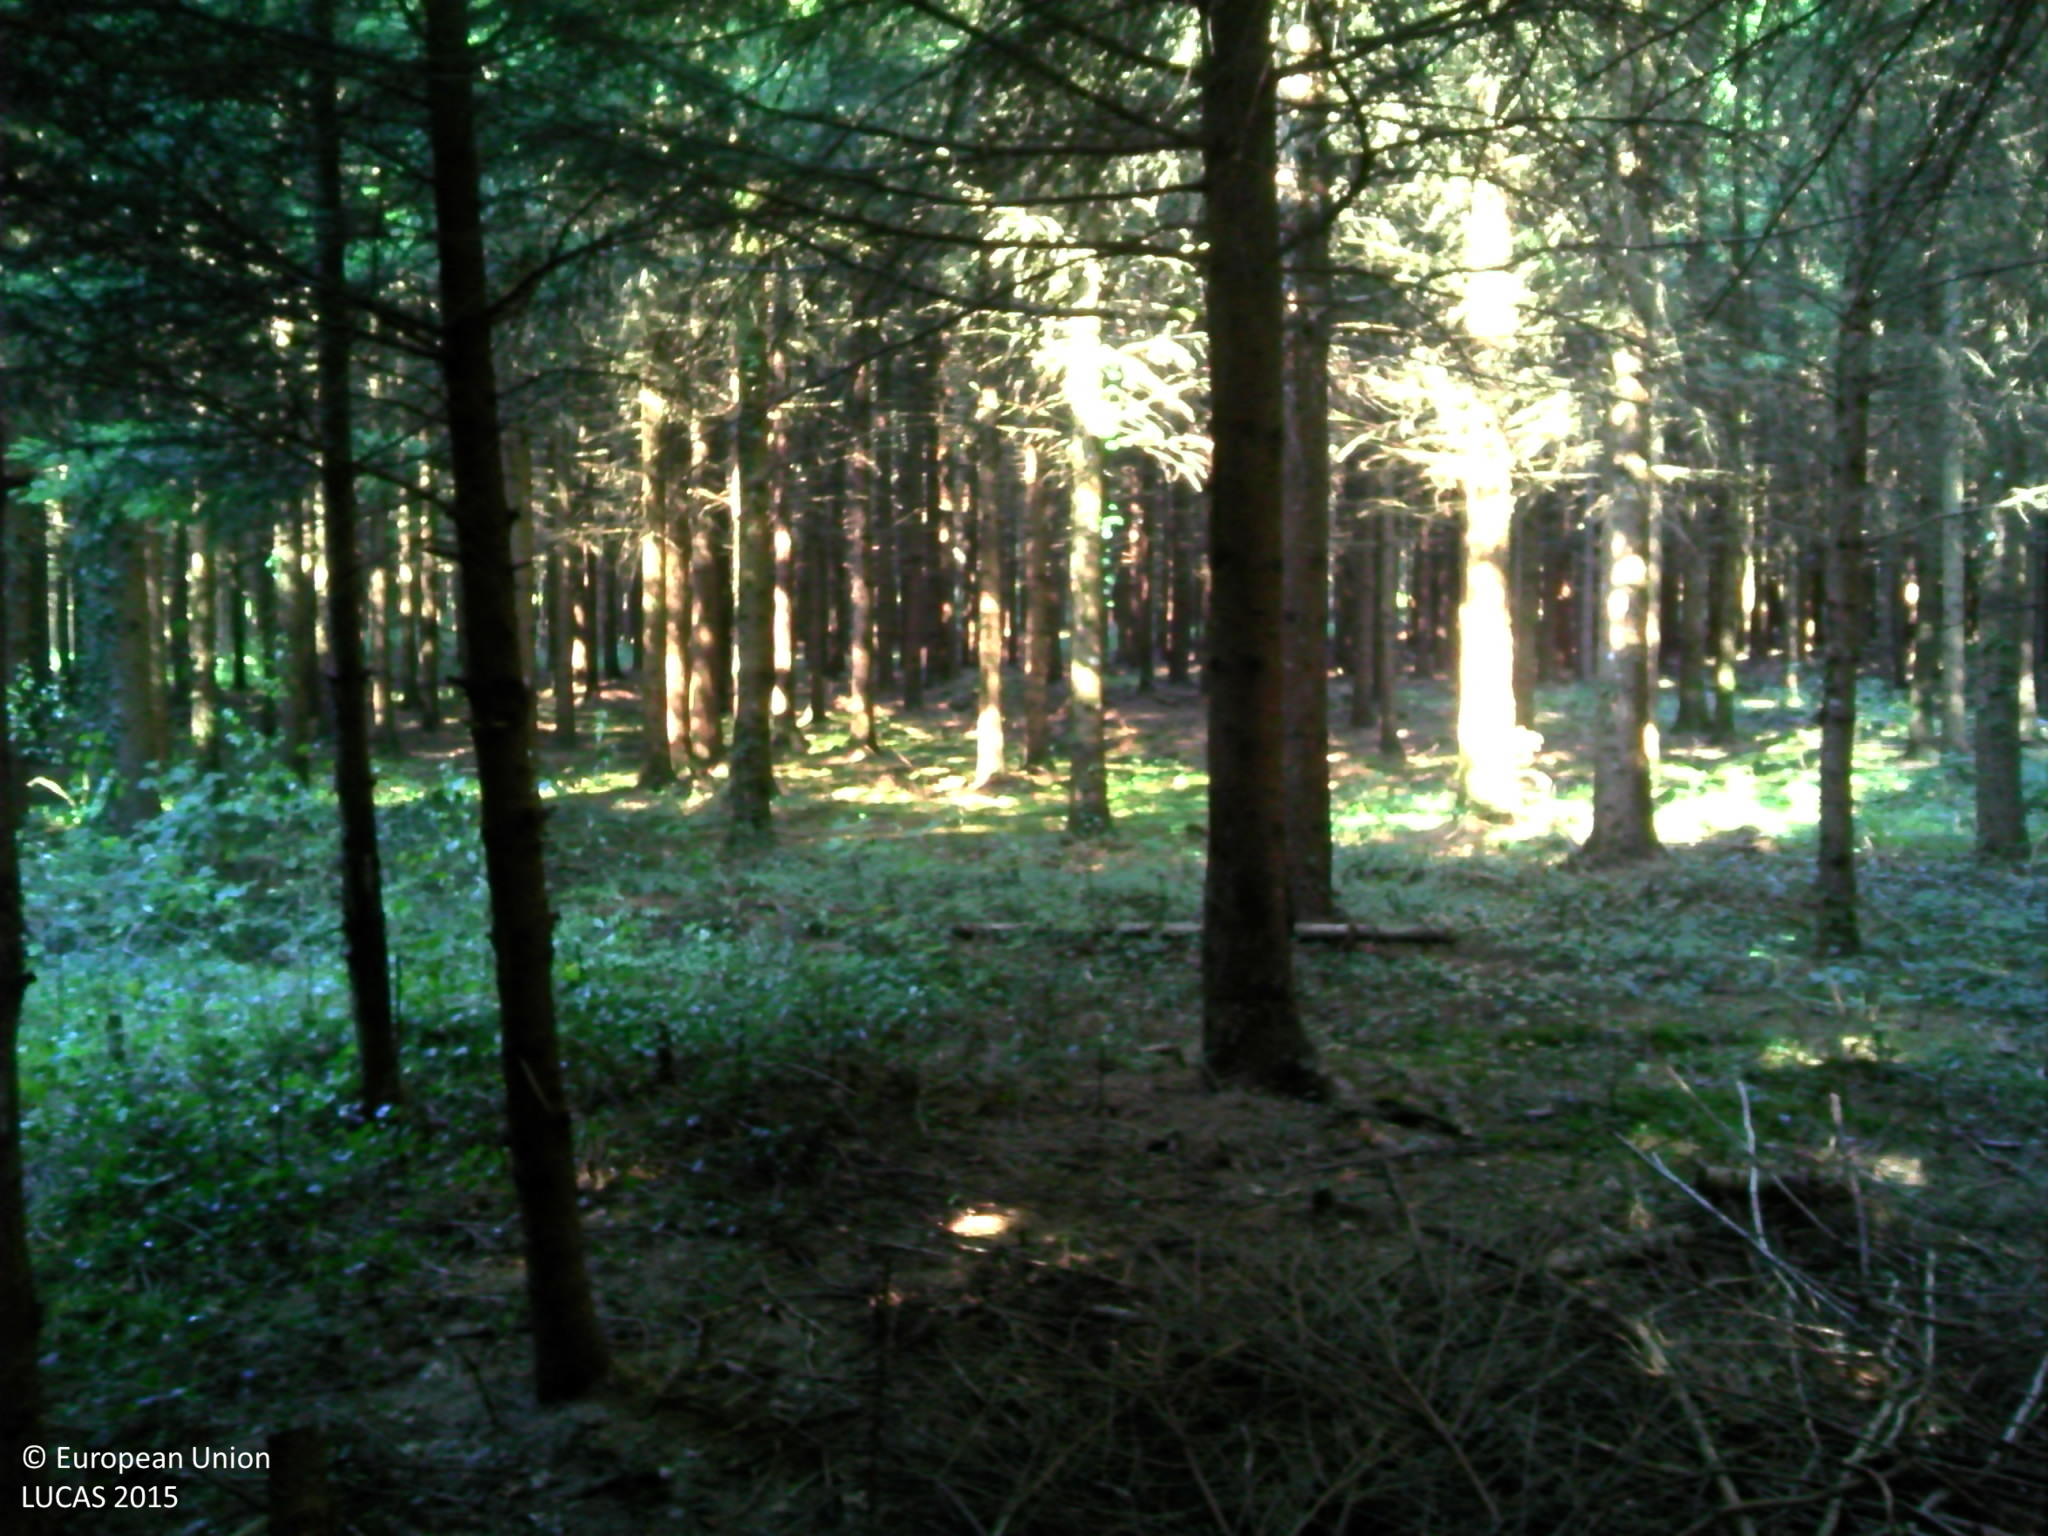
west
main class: Woodland
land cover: Spruce dominated coniferous woodland
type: alpine coniferous forest
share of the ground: > 75 %
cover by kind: coniferous forest trees 70 %, herbaceous plants 20 %, shrubs 10 %
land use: Forestry
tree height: > 5 m
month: September
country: FR
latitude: 47.2243
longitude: 6.2909
